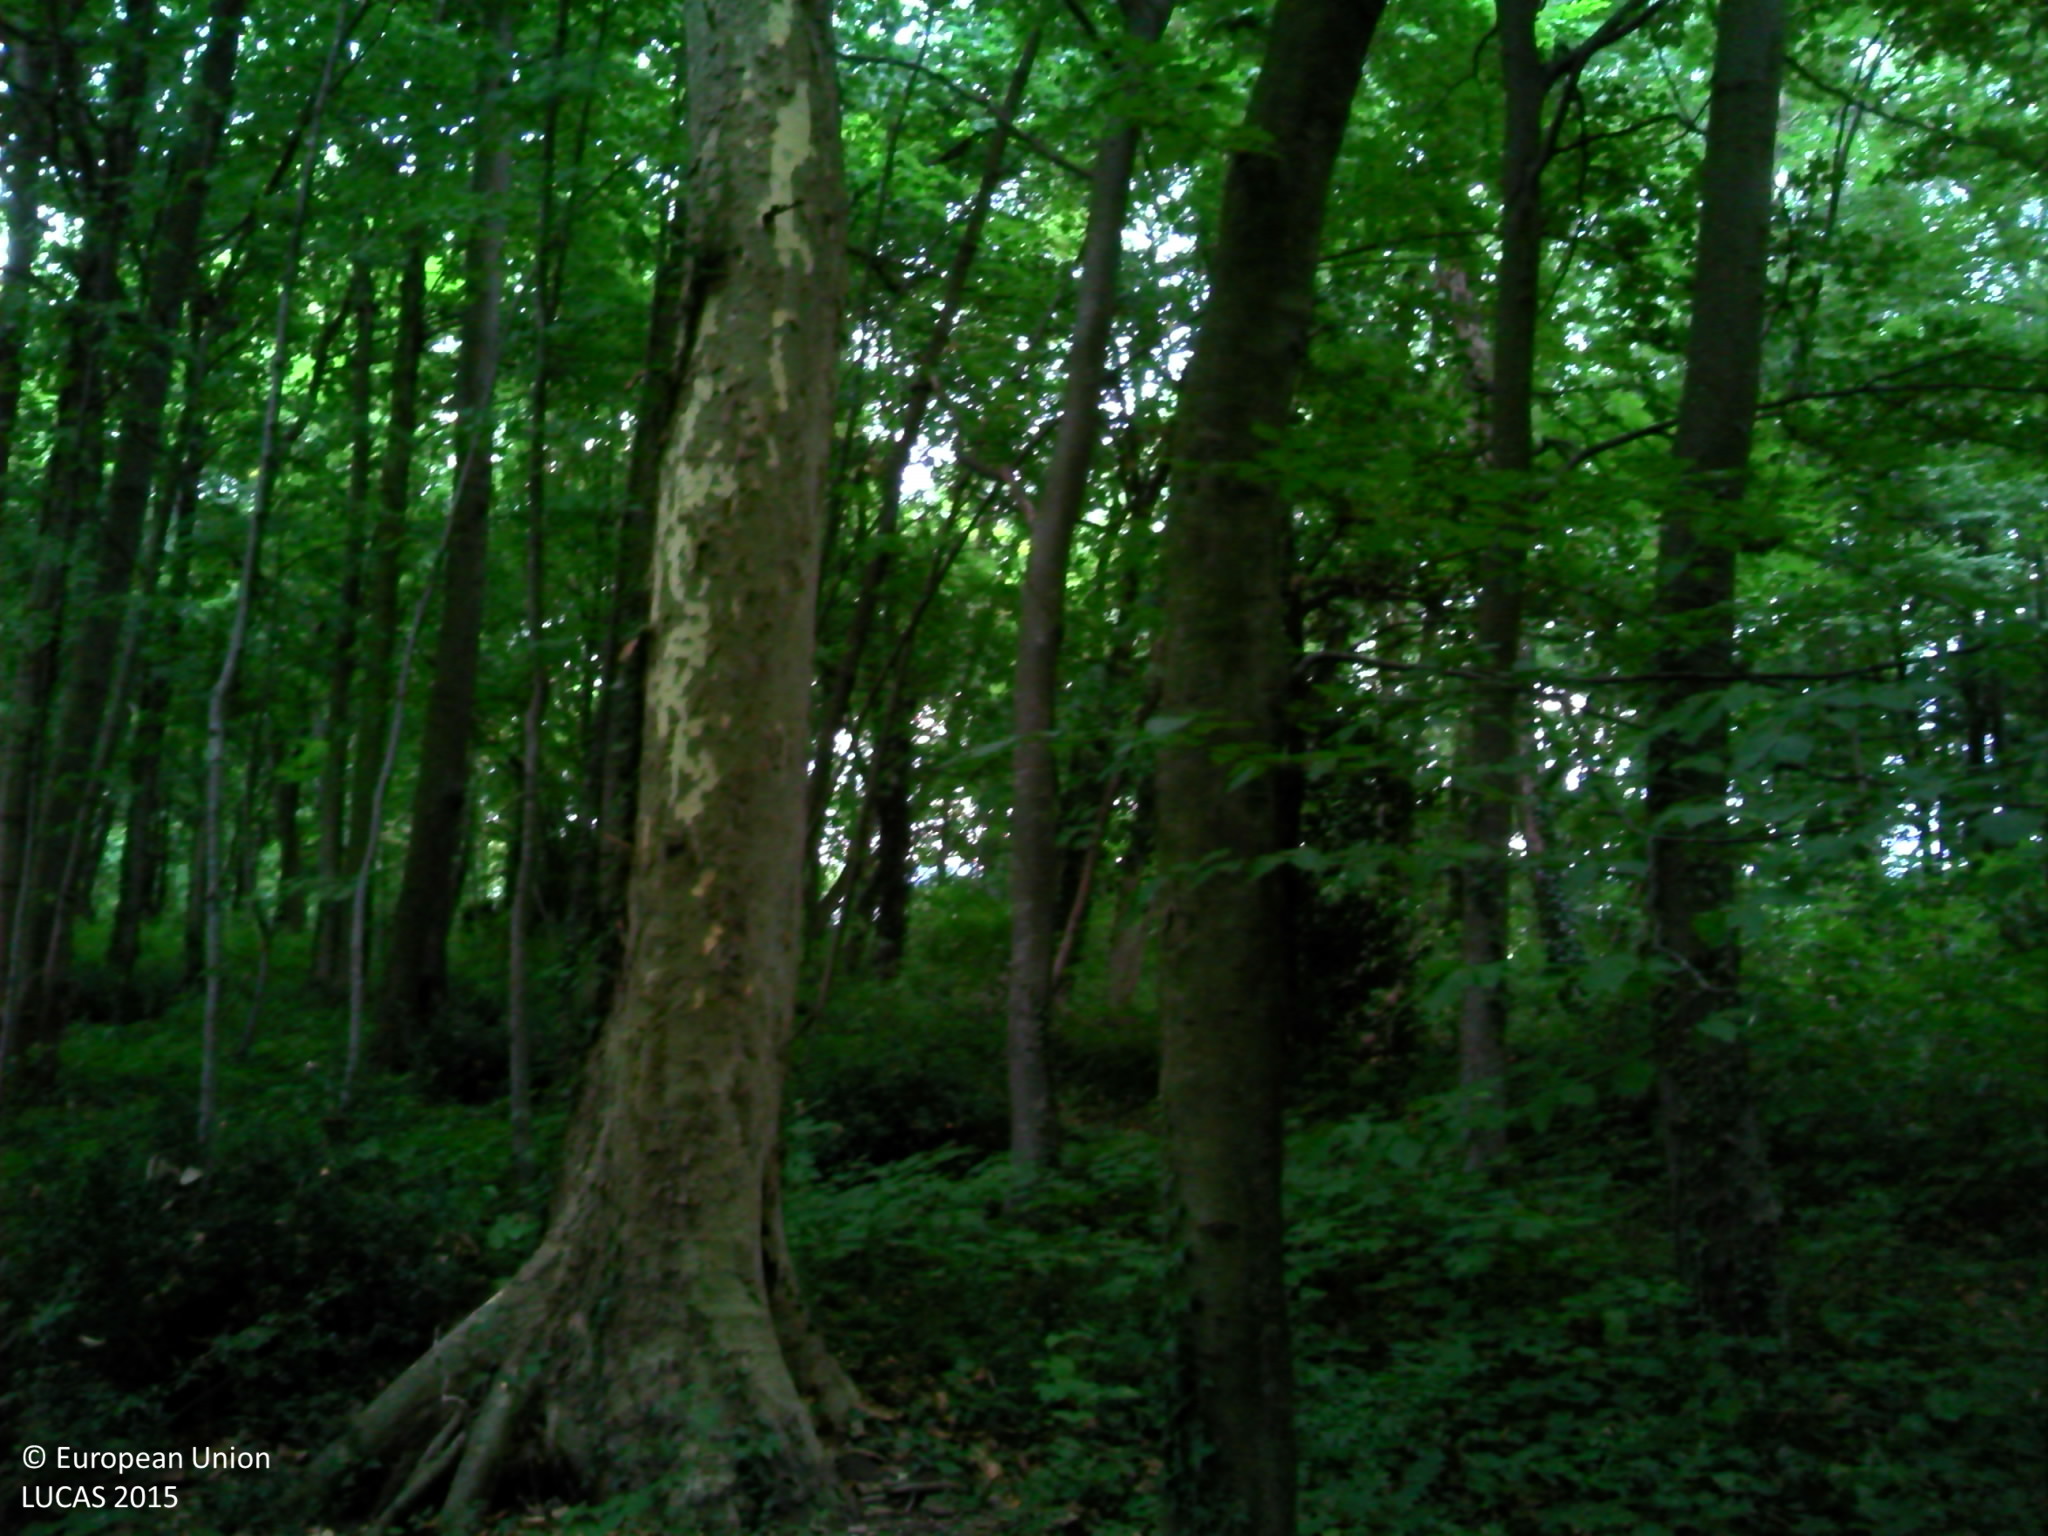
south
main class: Woodland
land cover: Broadleaved woodland
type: mesophytic deciduous forest
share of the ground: > 75 %
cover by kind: broadleaved forest trees 95 %, herbaceous plants 5 %
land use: Forestry
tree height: > 5 m
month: June
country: FR
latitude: 44.7511
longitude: 4.9411
